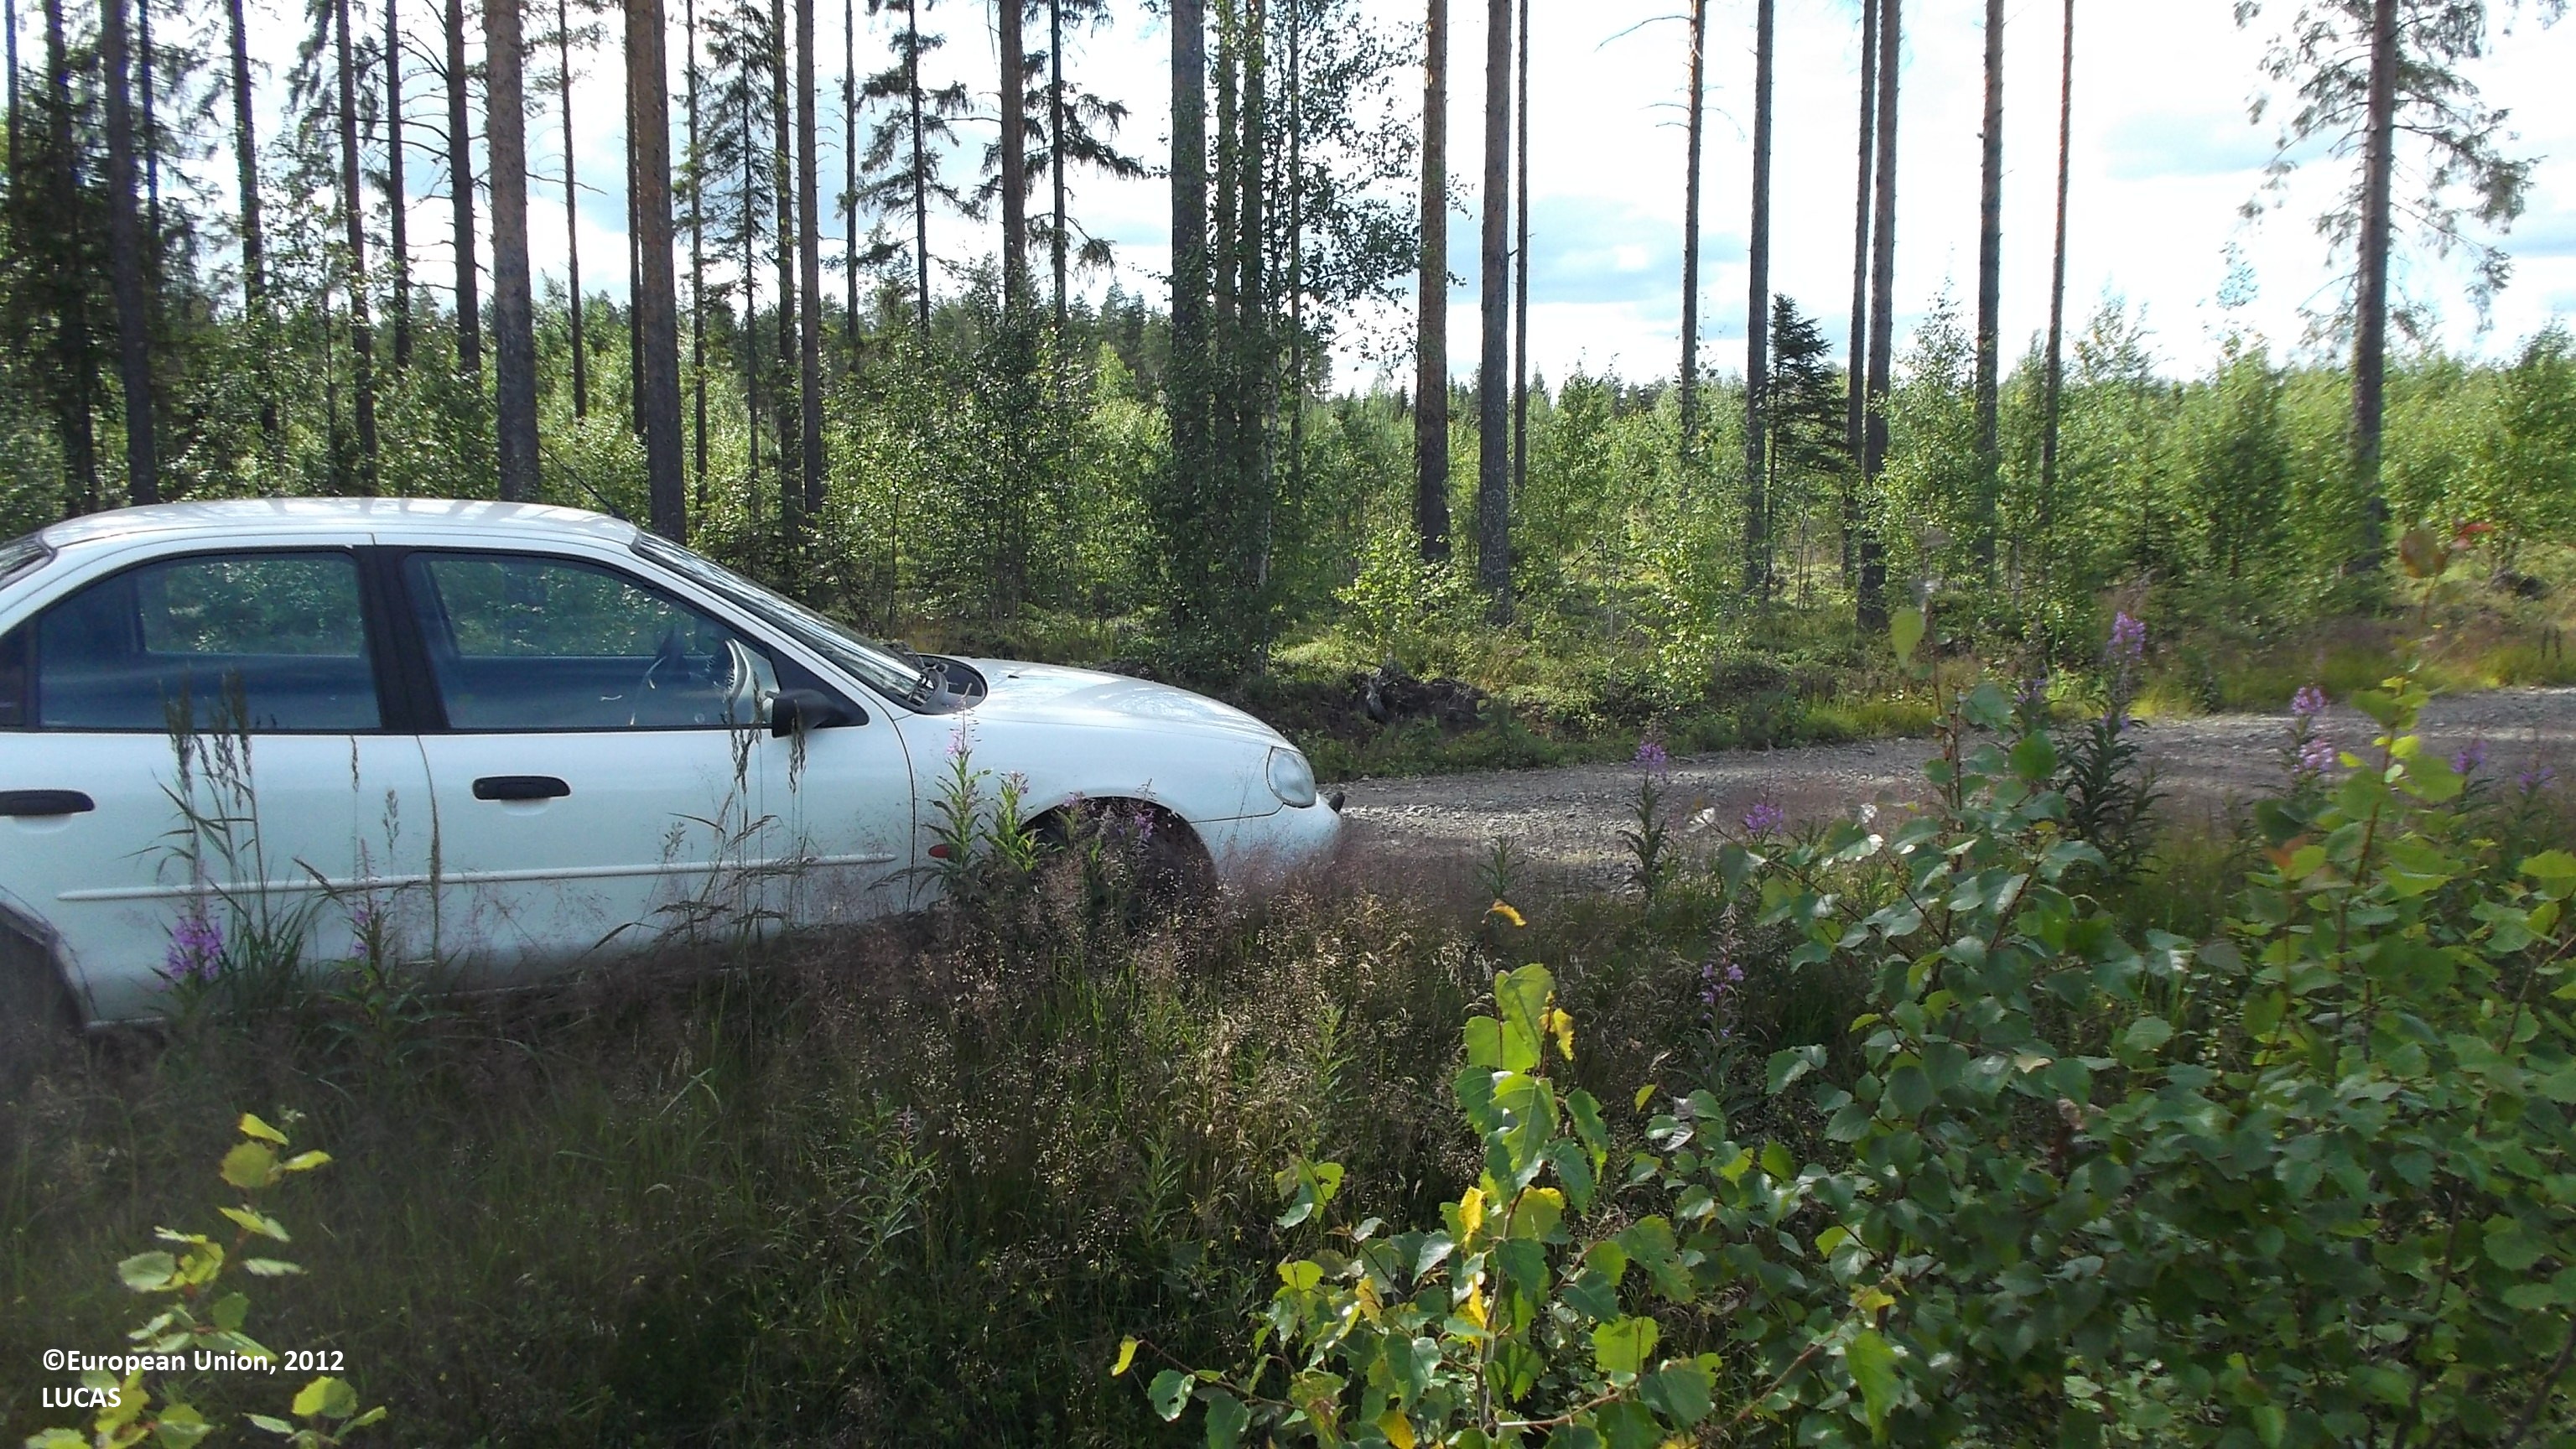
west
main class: Grassland
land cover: Grassland with sparse tree/shrub cover
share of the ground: 25 - 50 %
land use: Forestry
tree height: < 5 m
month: July
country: FI
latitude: 63.2977
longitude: 23.7720
